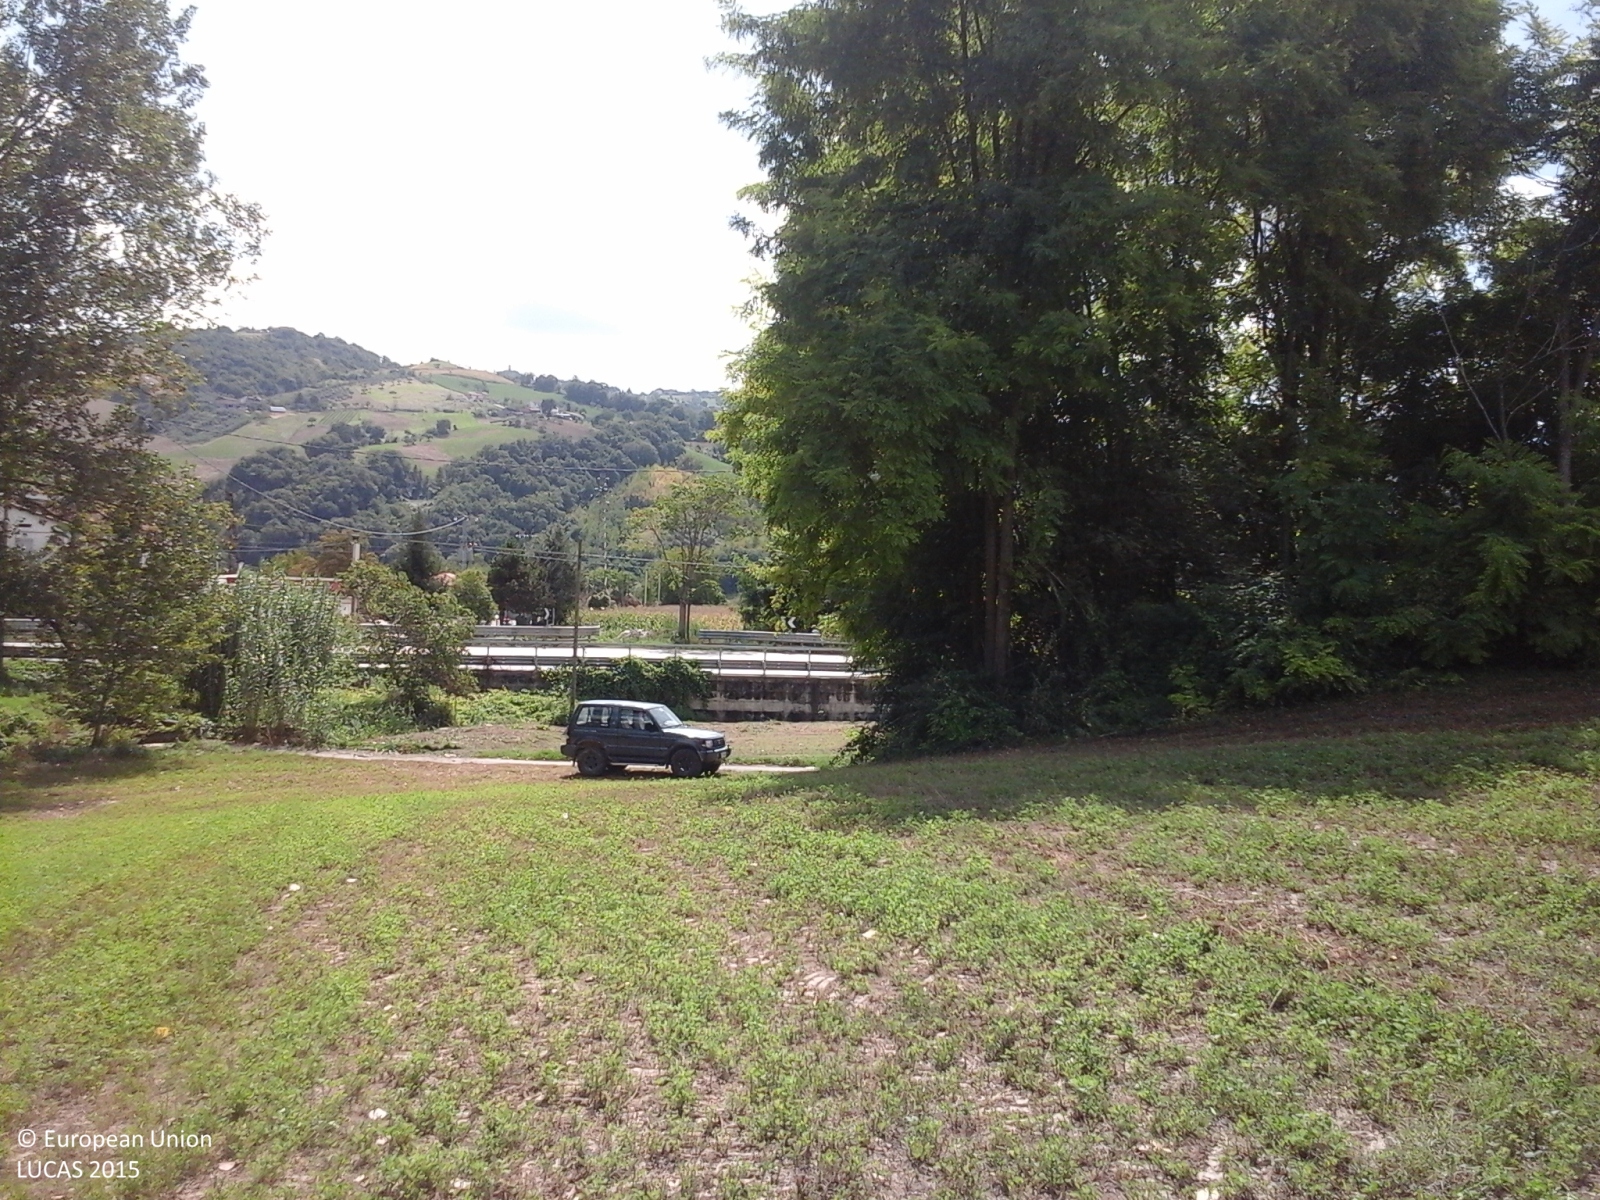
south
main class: Cropland
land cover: Lucerne
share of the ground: > 75 %
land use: Agriculture (excluding fallow land and kitchen gardens)
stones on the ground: < 10 %
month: September
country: IT
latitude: 42.6196
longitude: 13.7805
